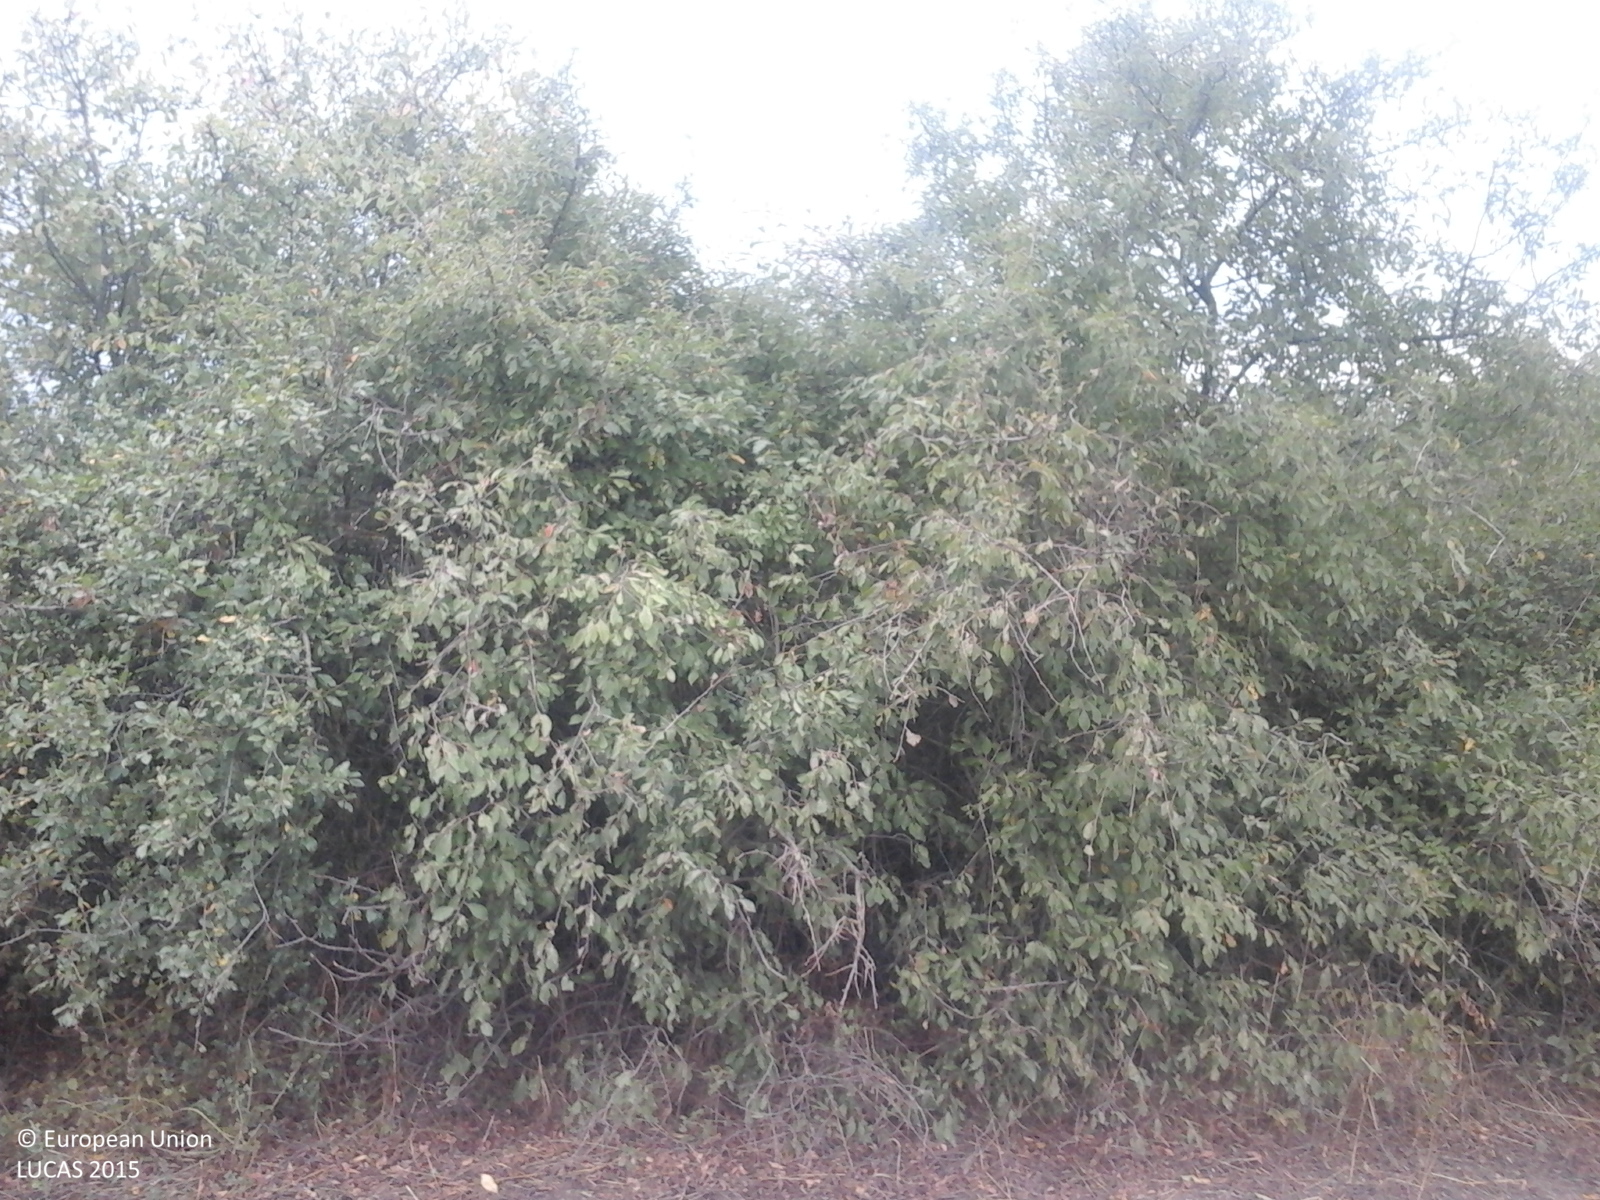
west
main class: Shrubland
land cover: Shrubland without tree cover
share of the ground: > 75 %
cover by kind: shrubs 100 %
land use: Semi-natural and natural areas not in use
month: September
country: RO
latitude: 47.6531
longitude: 22.6687
